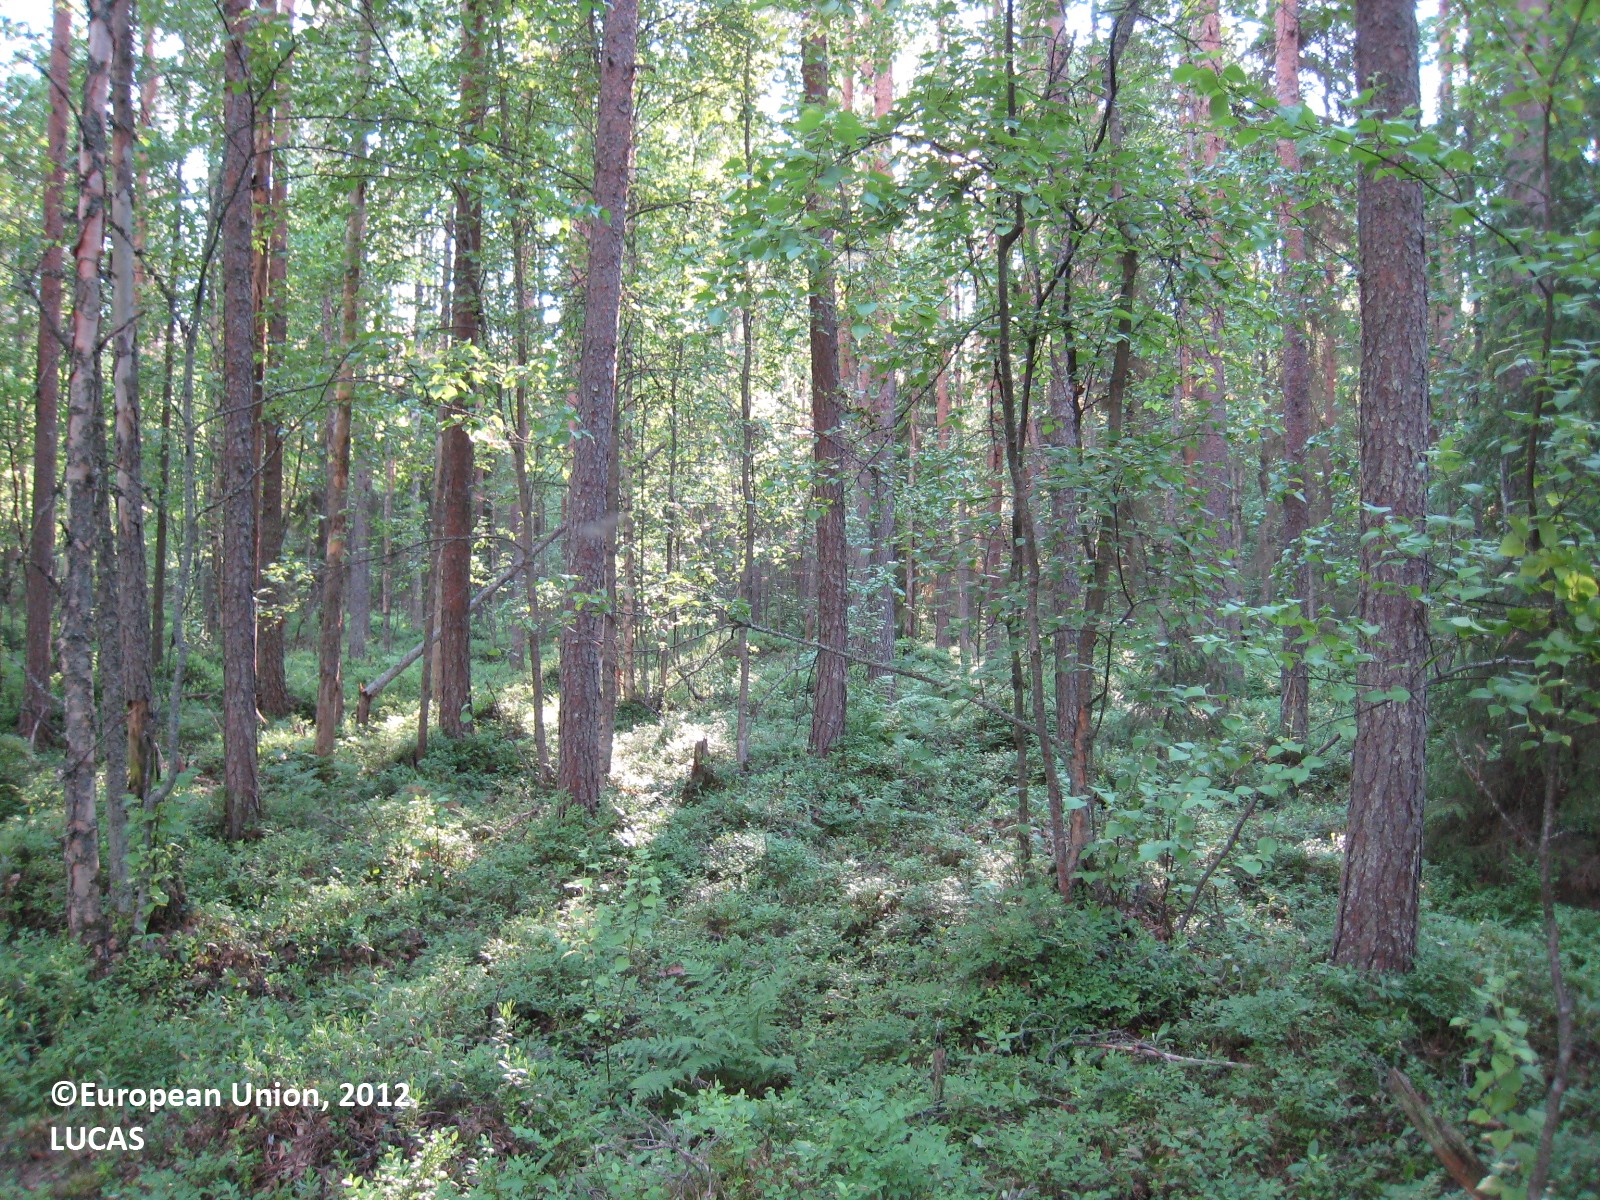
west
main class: Woodland
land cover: Pine dominated mixed woodland
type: boreal forest
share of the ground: 50 - 75 %
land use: Forestry
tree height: > 5 m
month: June
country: FI
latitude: 62.0120
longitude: 26.1199
